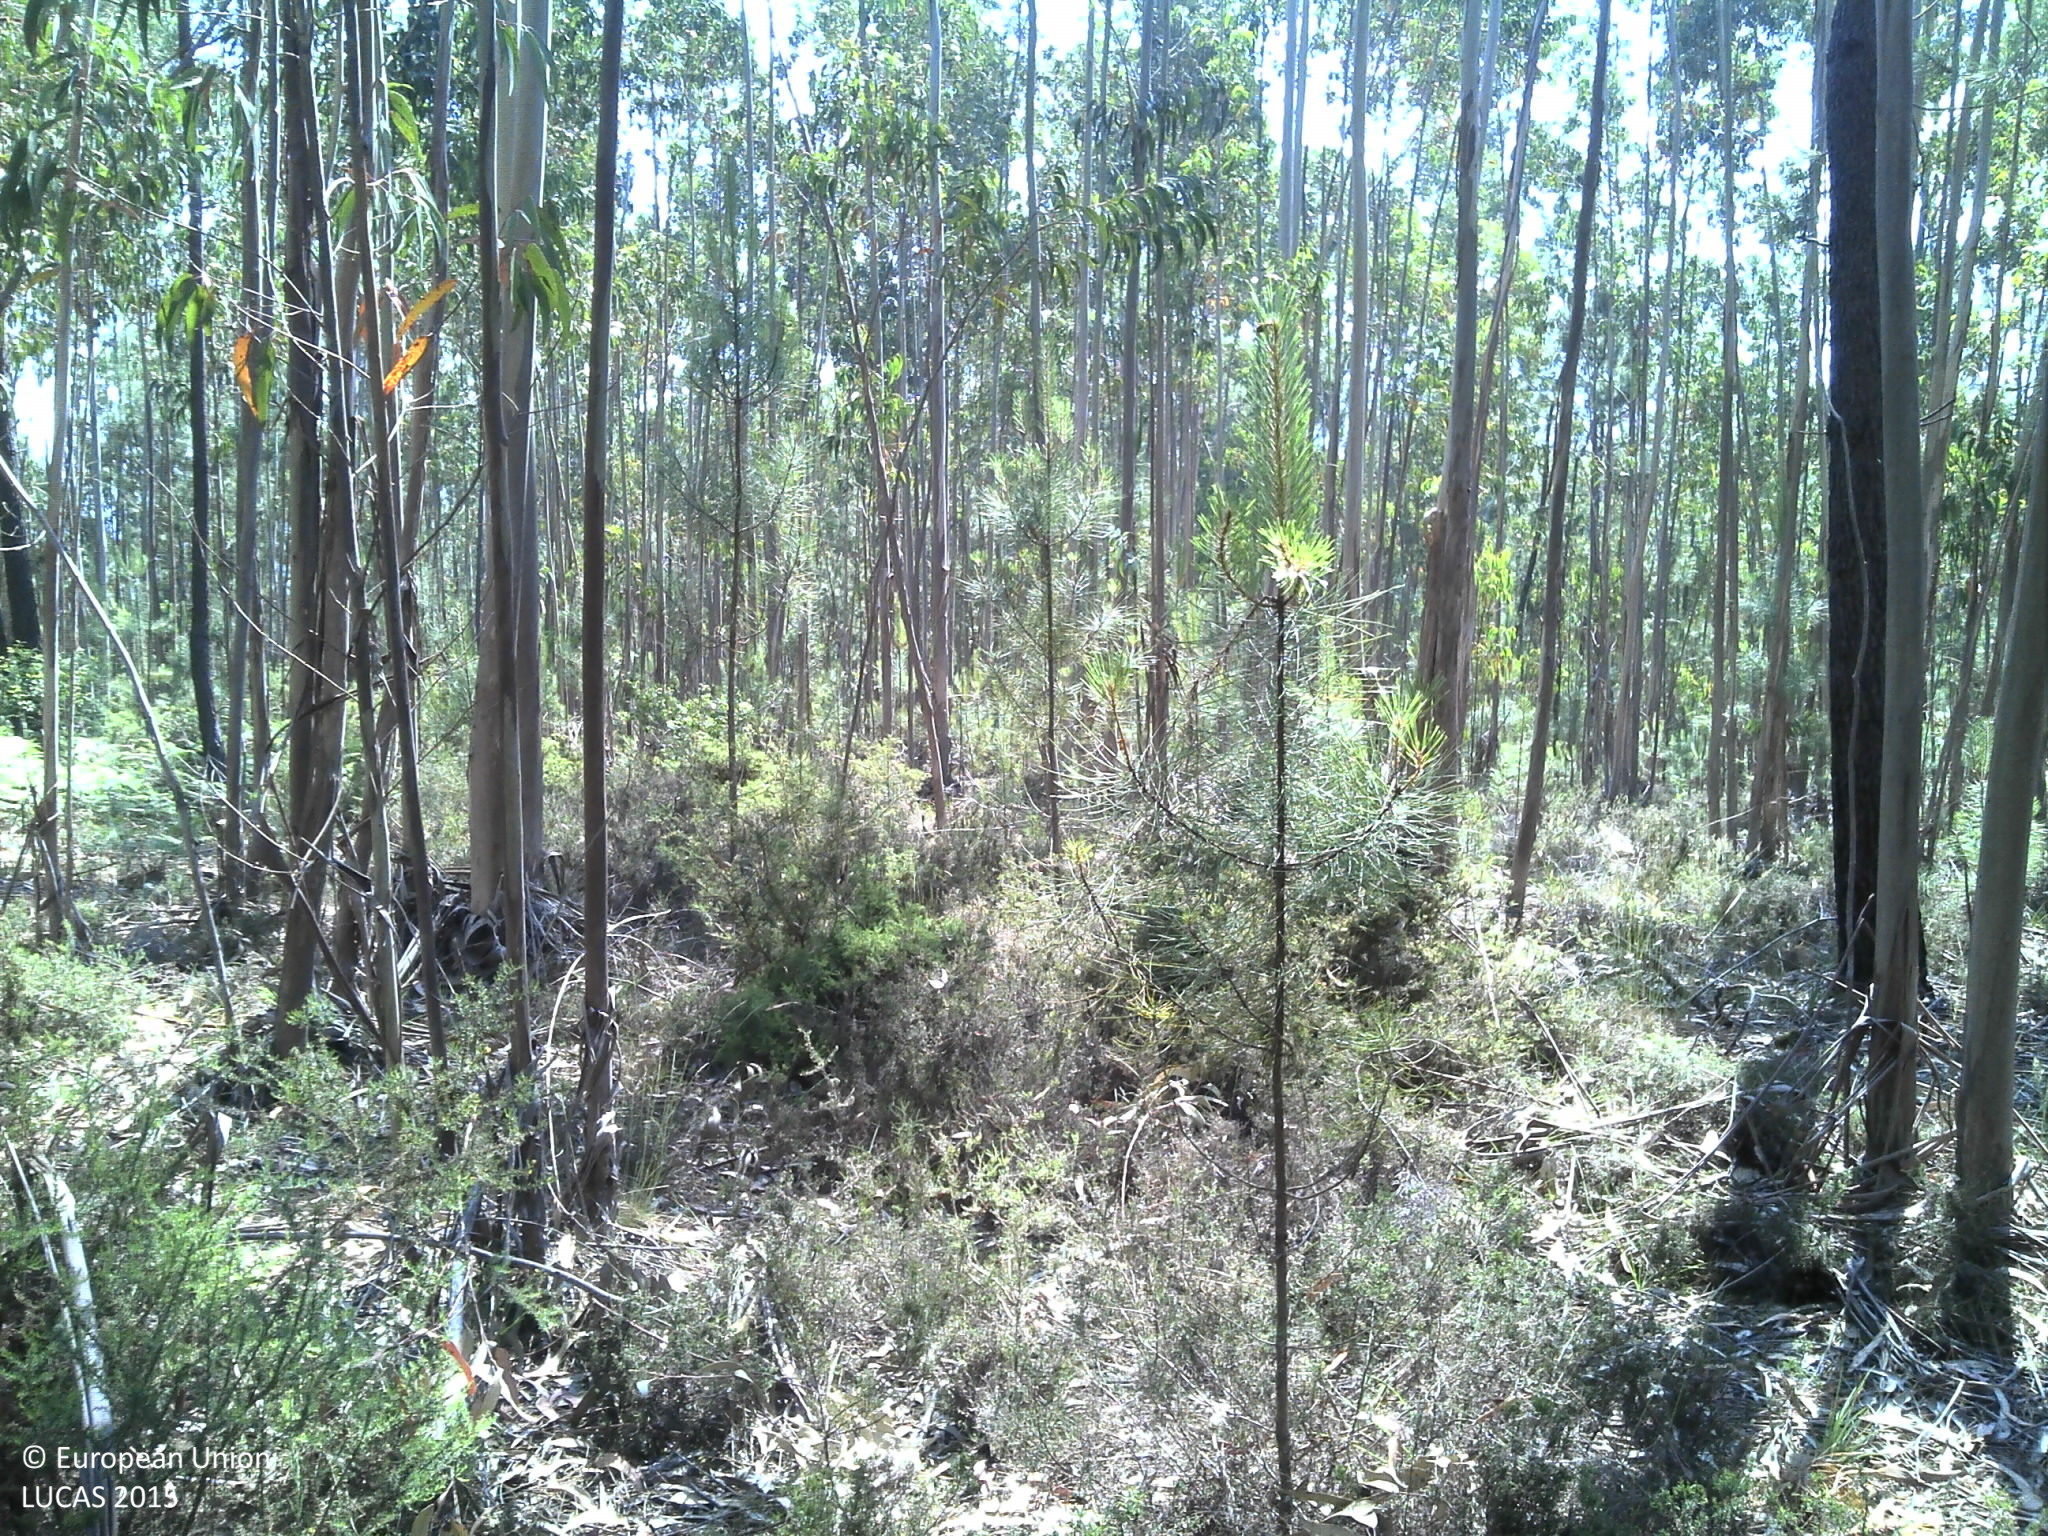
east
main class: Woodland
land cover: Broadleaved woodland
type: exotic forest
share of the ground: 50 - 75 %
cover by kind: broadleaved forest trees 70 %, shrubs 25 %, unconsolidated bare surface 5 %
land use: Forestry
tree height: > 5 m
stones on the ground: < 10 %
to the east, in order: Broadleaved woodland; Tracks; Broadleaved woodland; Tracks; Broadleaved woodland
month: June
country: PT
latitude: 40.8195
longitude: -8.4114
